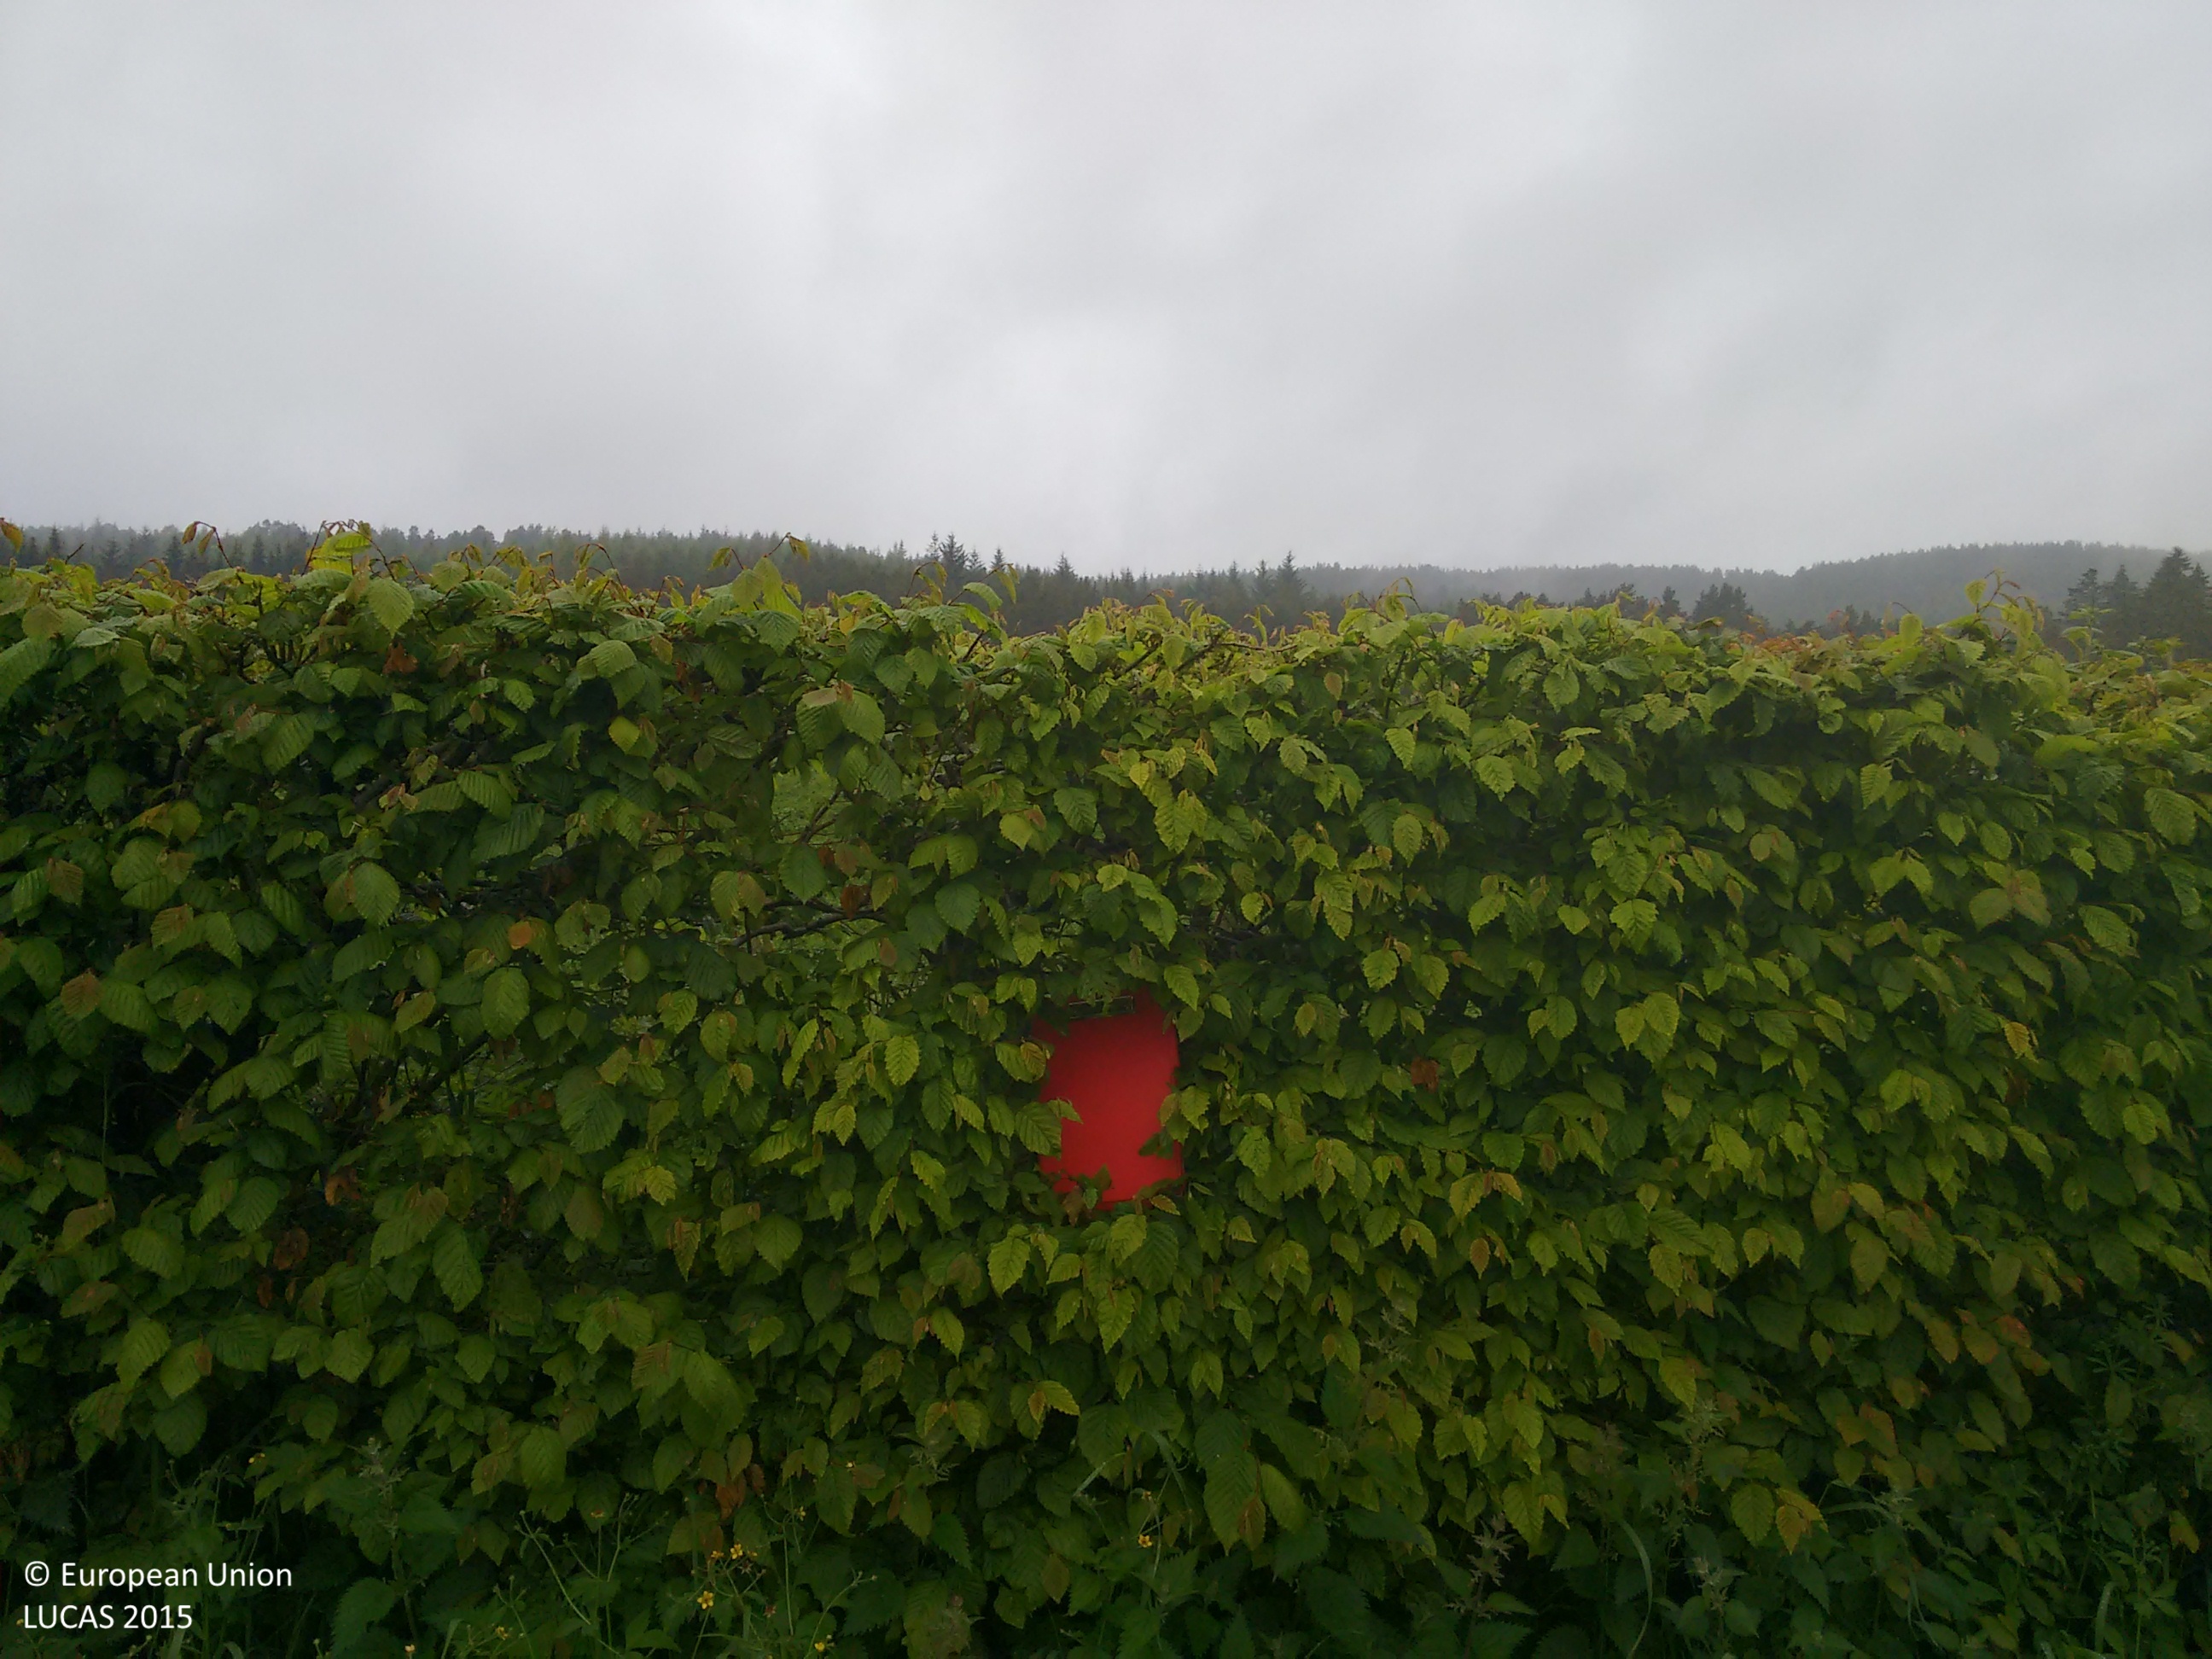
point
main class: Shrubland
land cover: Shrubland without tree cover
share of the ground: > 75 %
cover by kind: shrubs 50 %, herbaceous plants 50 %
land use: Semi-natural and natural areas not in use
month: June
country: GB
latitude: 57.0500
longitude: -2.8698
